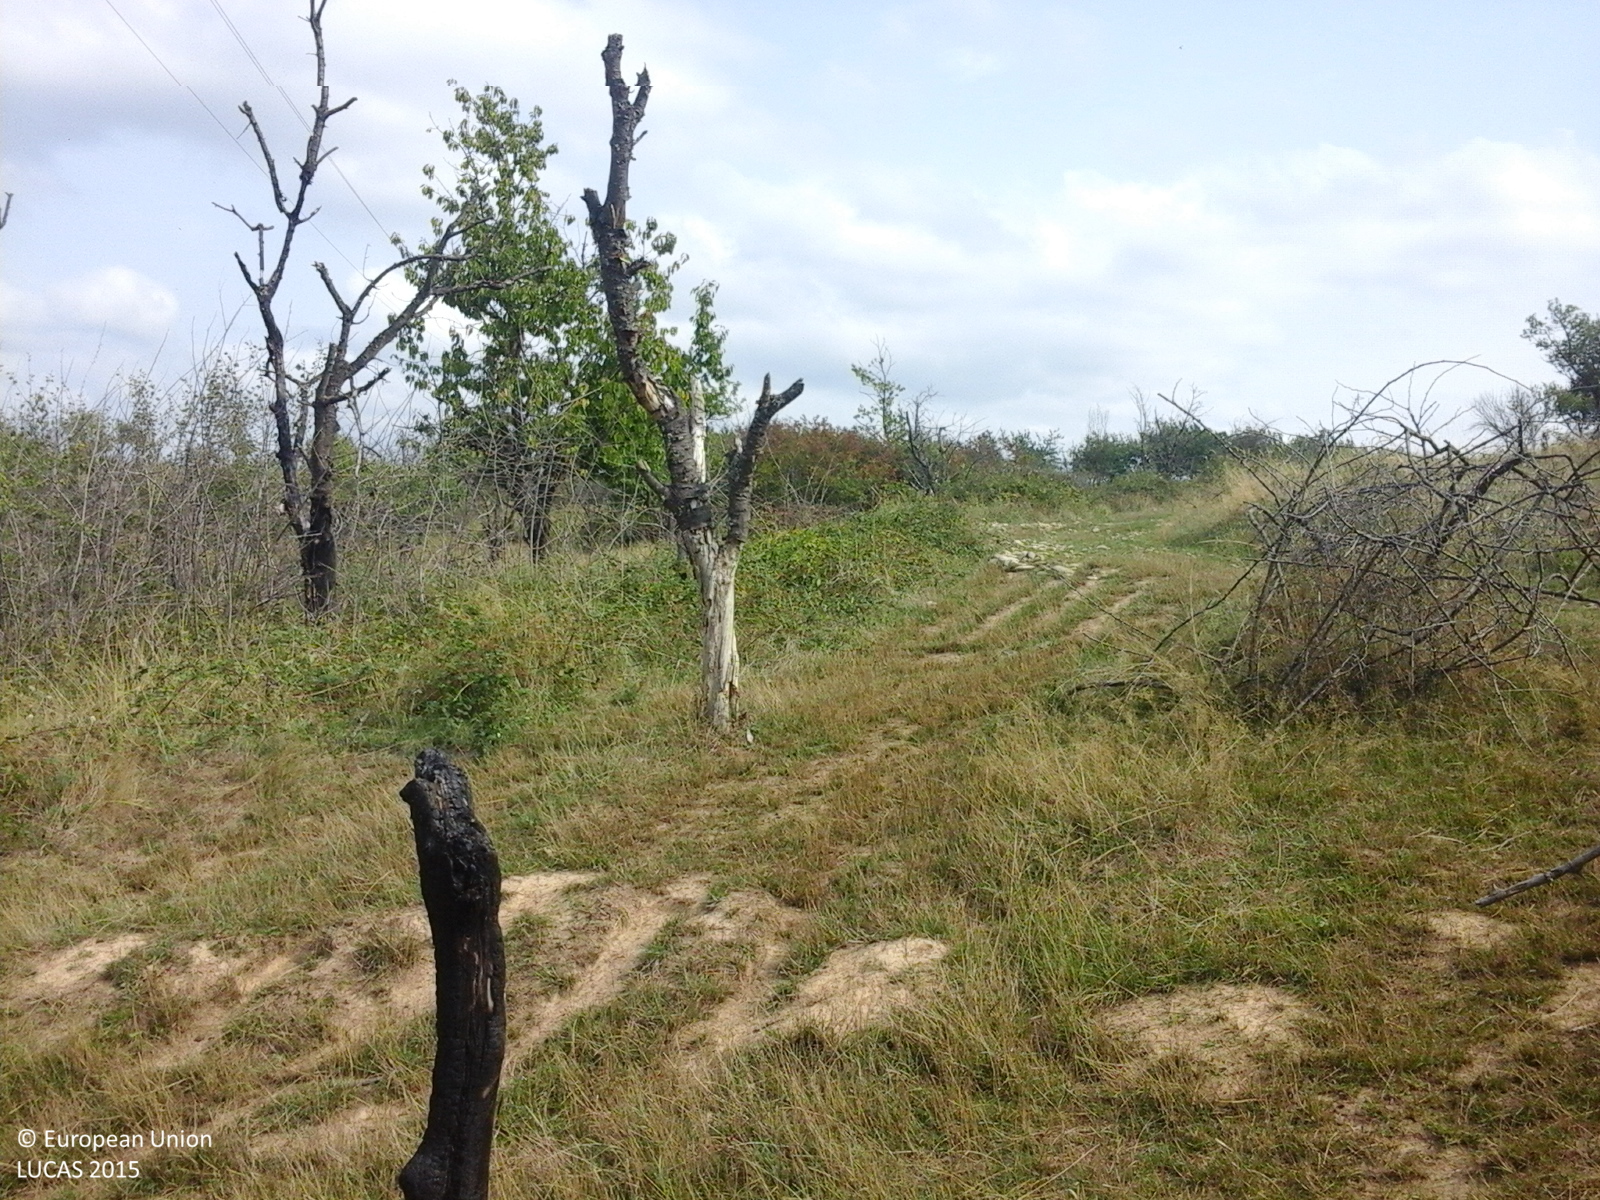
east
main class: Cropland
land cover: Cherry fruit
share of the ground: 25 - 50 %
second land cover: Grassland without tree/shrub cover
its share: > 75 %
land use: Agriculture (excluding fallow land and kitchen gardens)
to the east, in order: Tracks; Cherry fruit; Grassland without tree/shrub cover; Tracks; Other fruit trees and berries; Electric lines; Other fruit trees and berries
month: September
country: RO
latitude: 45.5145
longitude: 22.1113
